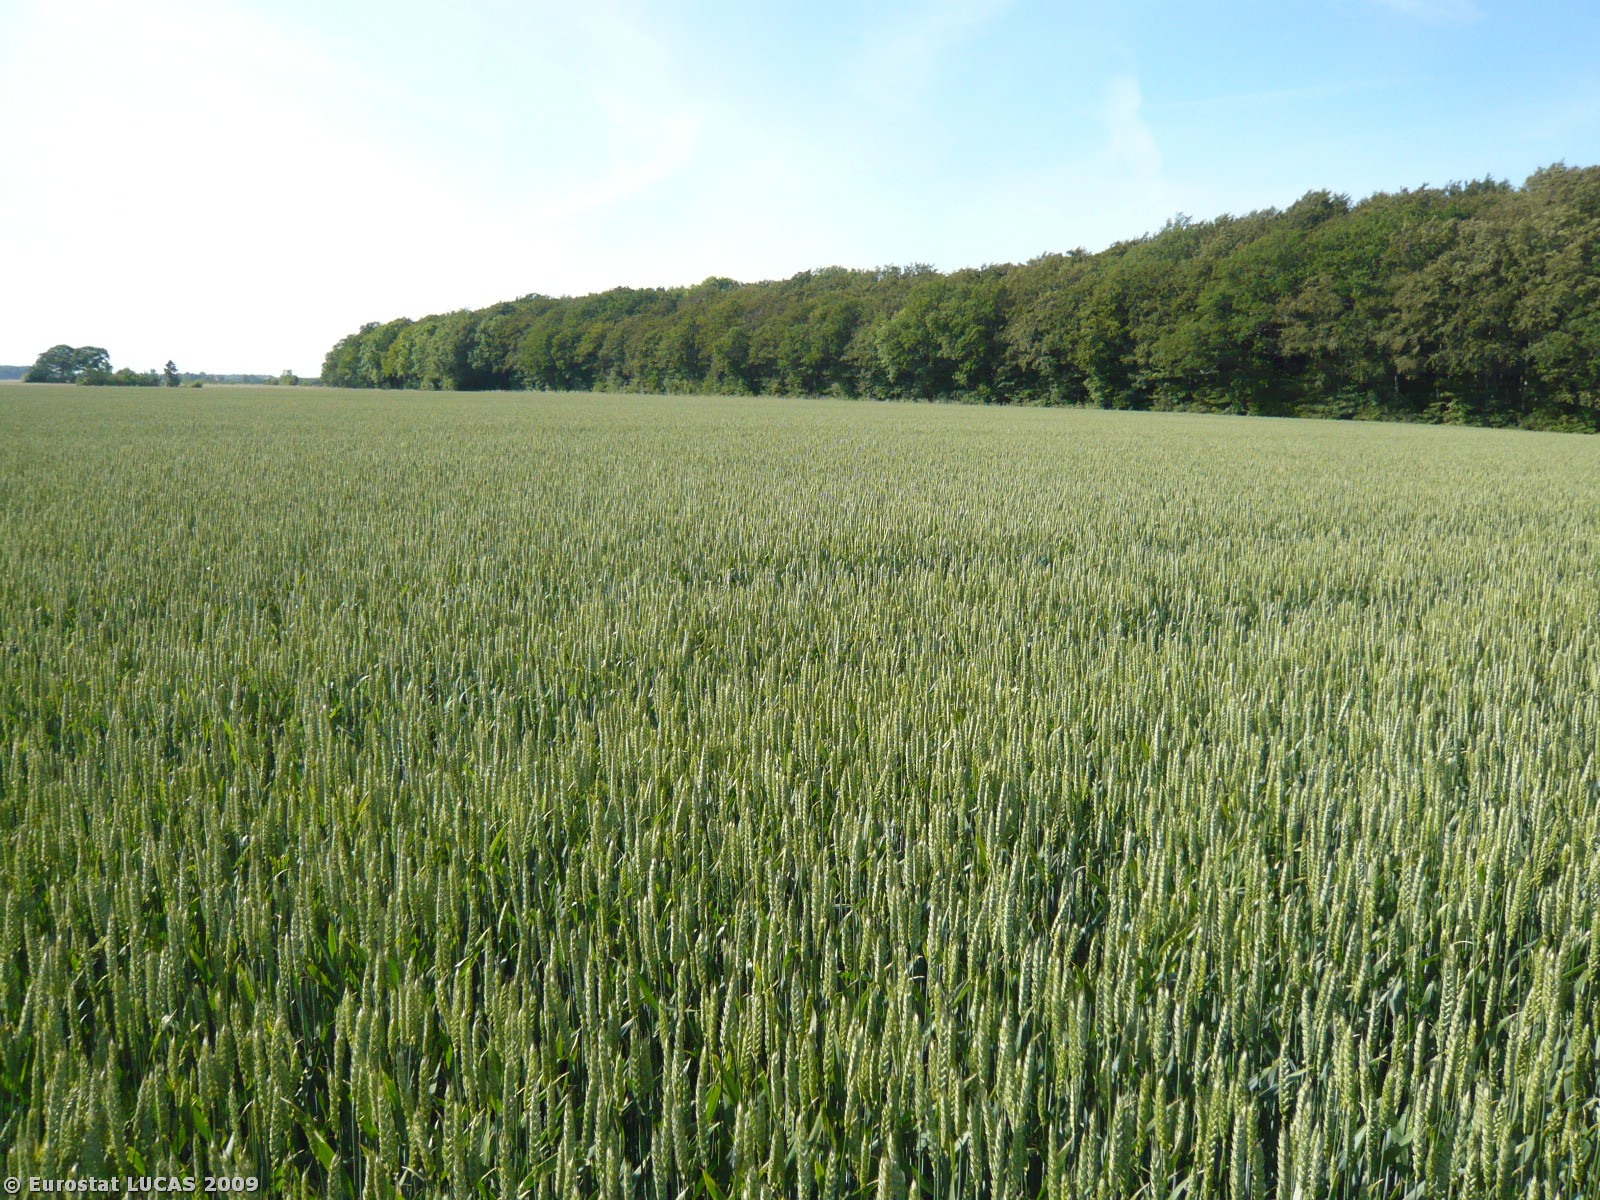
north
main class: Cropland
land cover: Common wheat
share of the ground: > 75 %
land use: Agriculture (excluding fallow land and kitchen gardens)
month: June
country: DK
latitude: 54.7964
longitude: 11.3523
